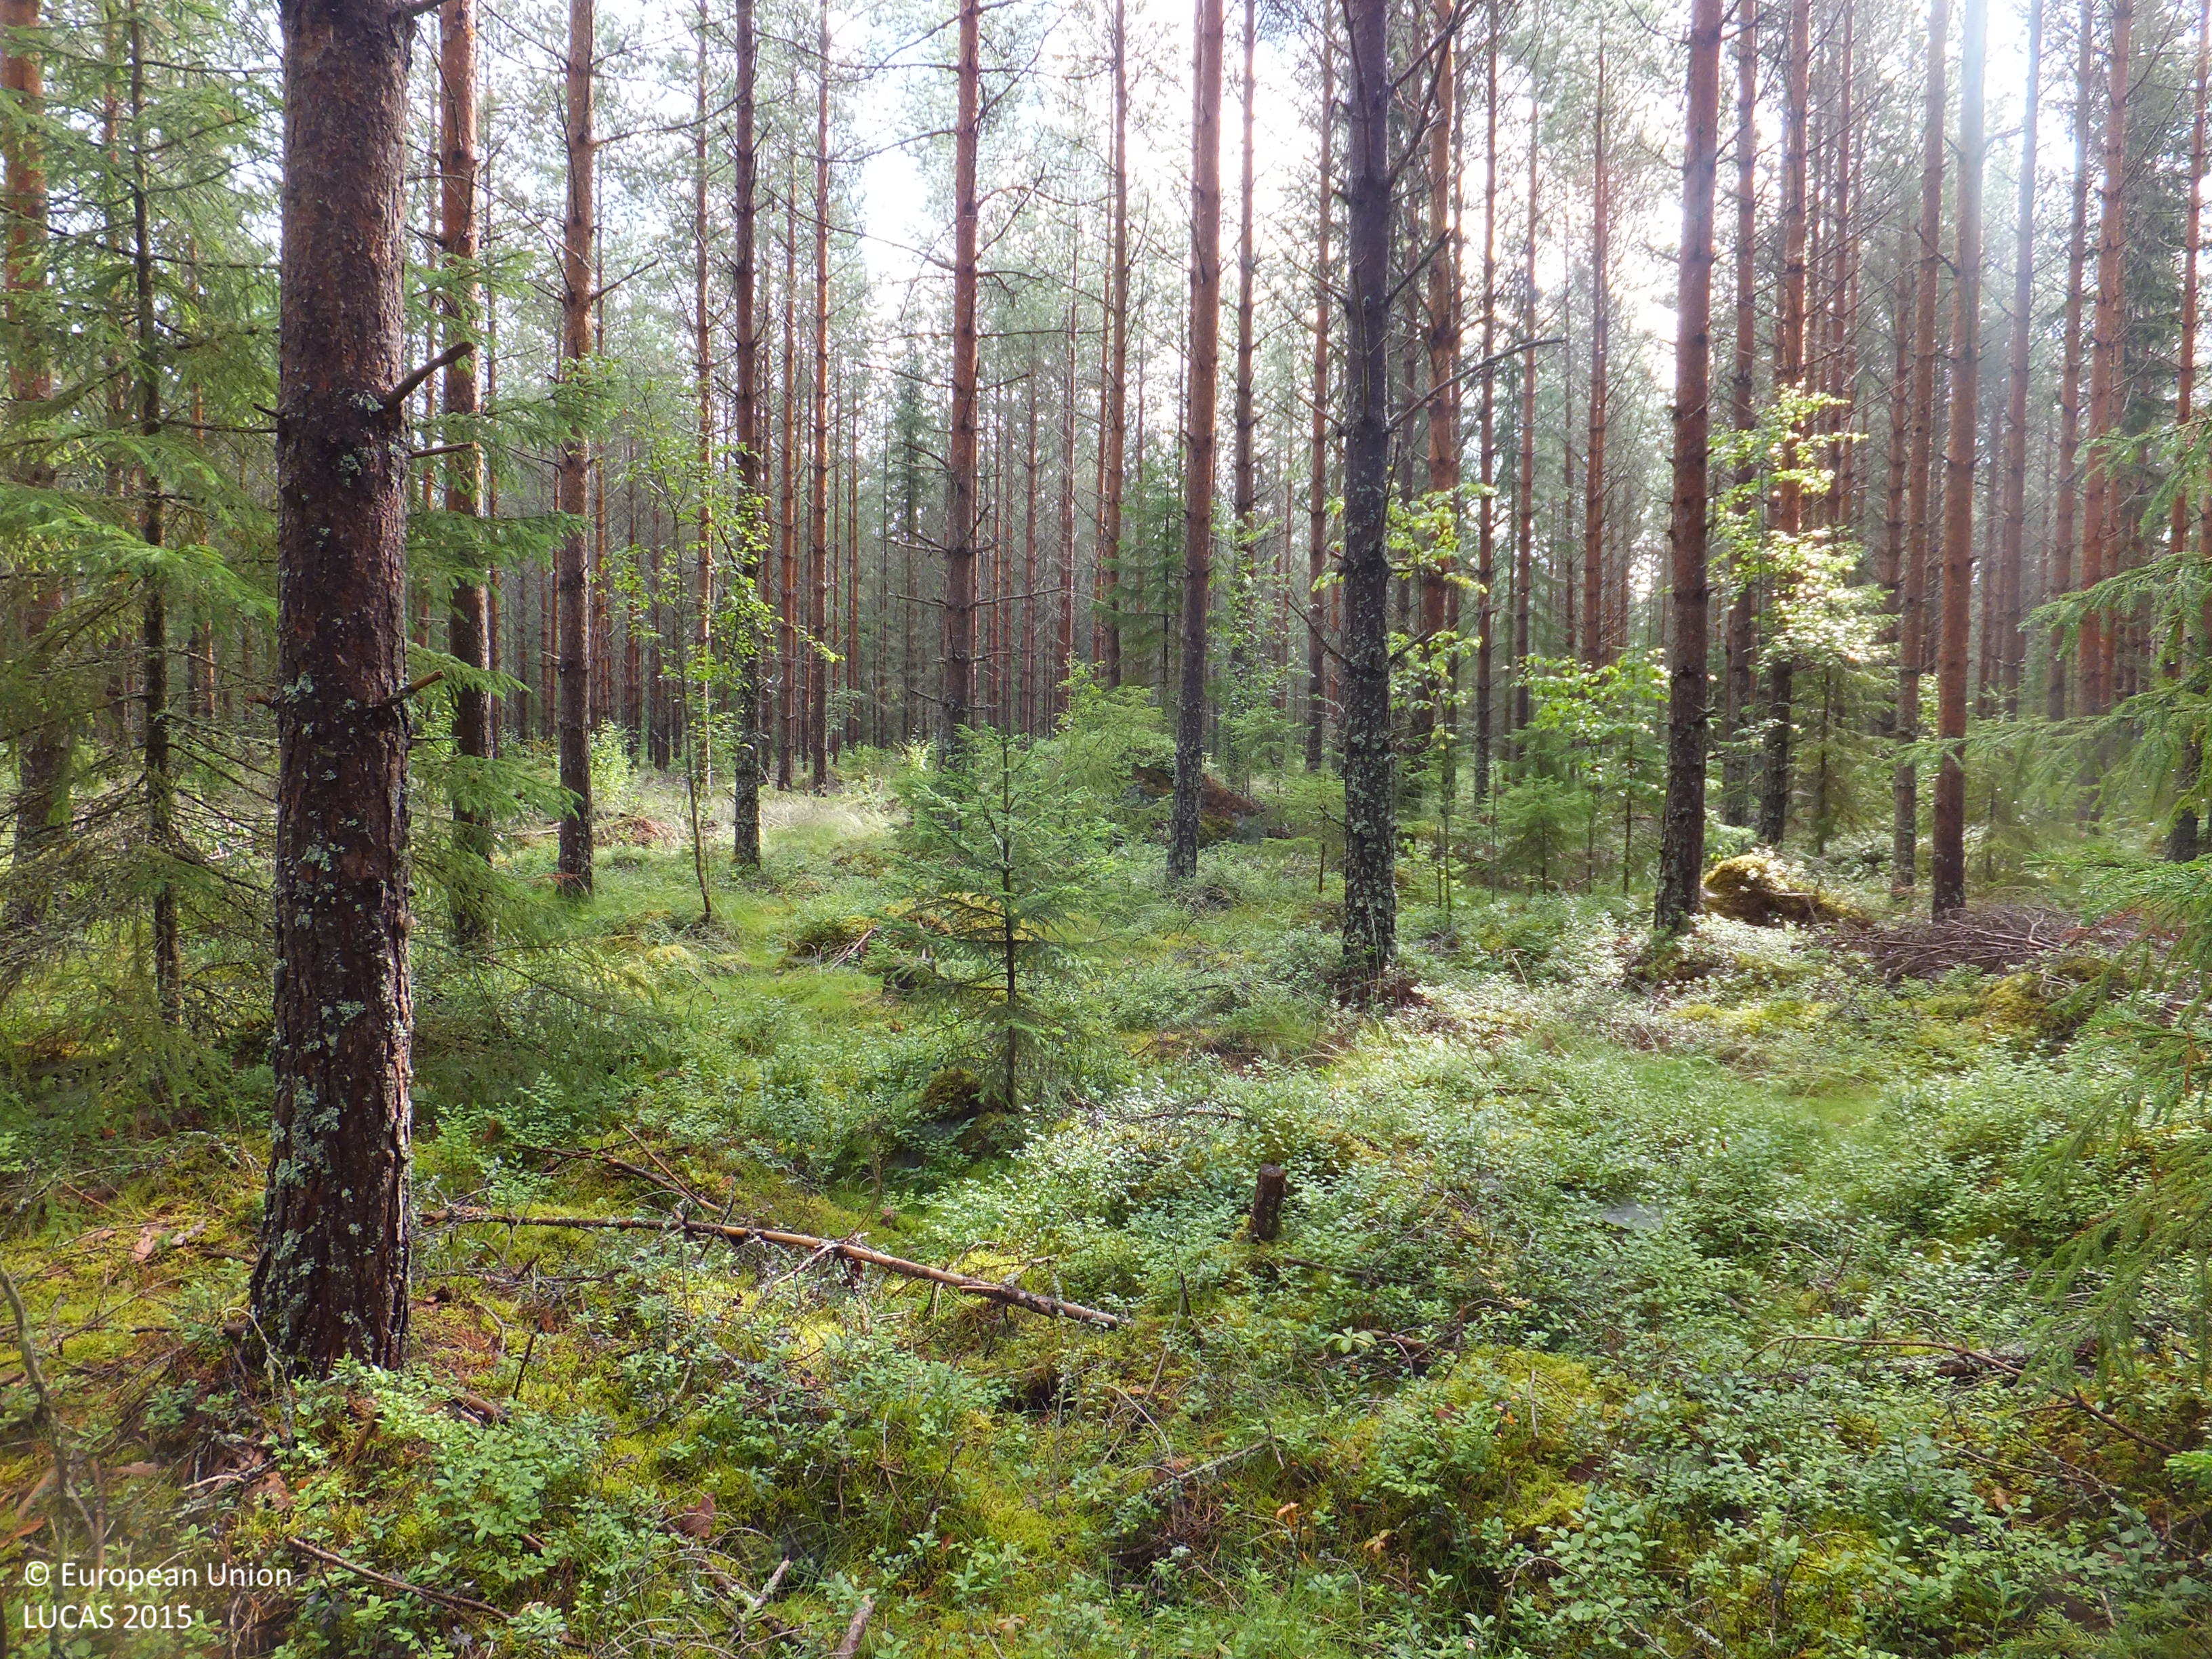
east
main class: Woodland
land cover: Pine dominated coniferous woodland
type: boreal forest
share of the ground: > 75 %
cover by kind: coniferous forest trees 70 %, shrubs 10 %, lichens and mosses 10 %, broadleaved forest trees 5 %, herbaceous plants 5 %
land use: Forestry
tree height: > 5 m
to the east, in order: Pine dominated coniferous woodland; Shrubland without tree cover; Spruce dominated coniferous woodland; Ditches and canals; Other mixed woodland; Pine dominated coniferous woodland; Ditches and canals; Pine dominated mixed woodland
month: July
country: FI
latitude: 63.1711
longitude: 22.0196
